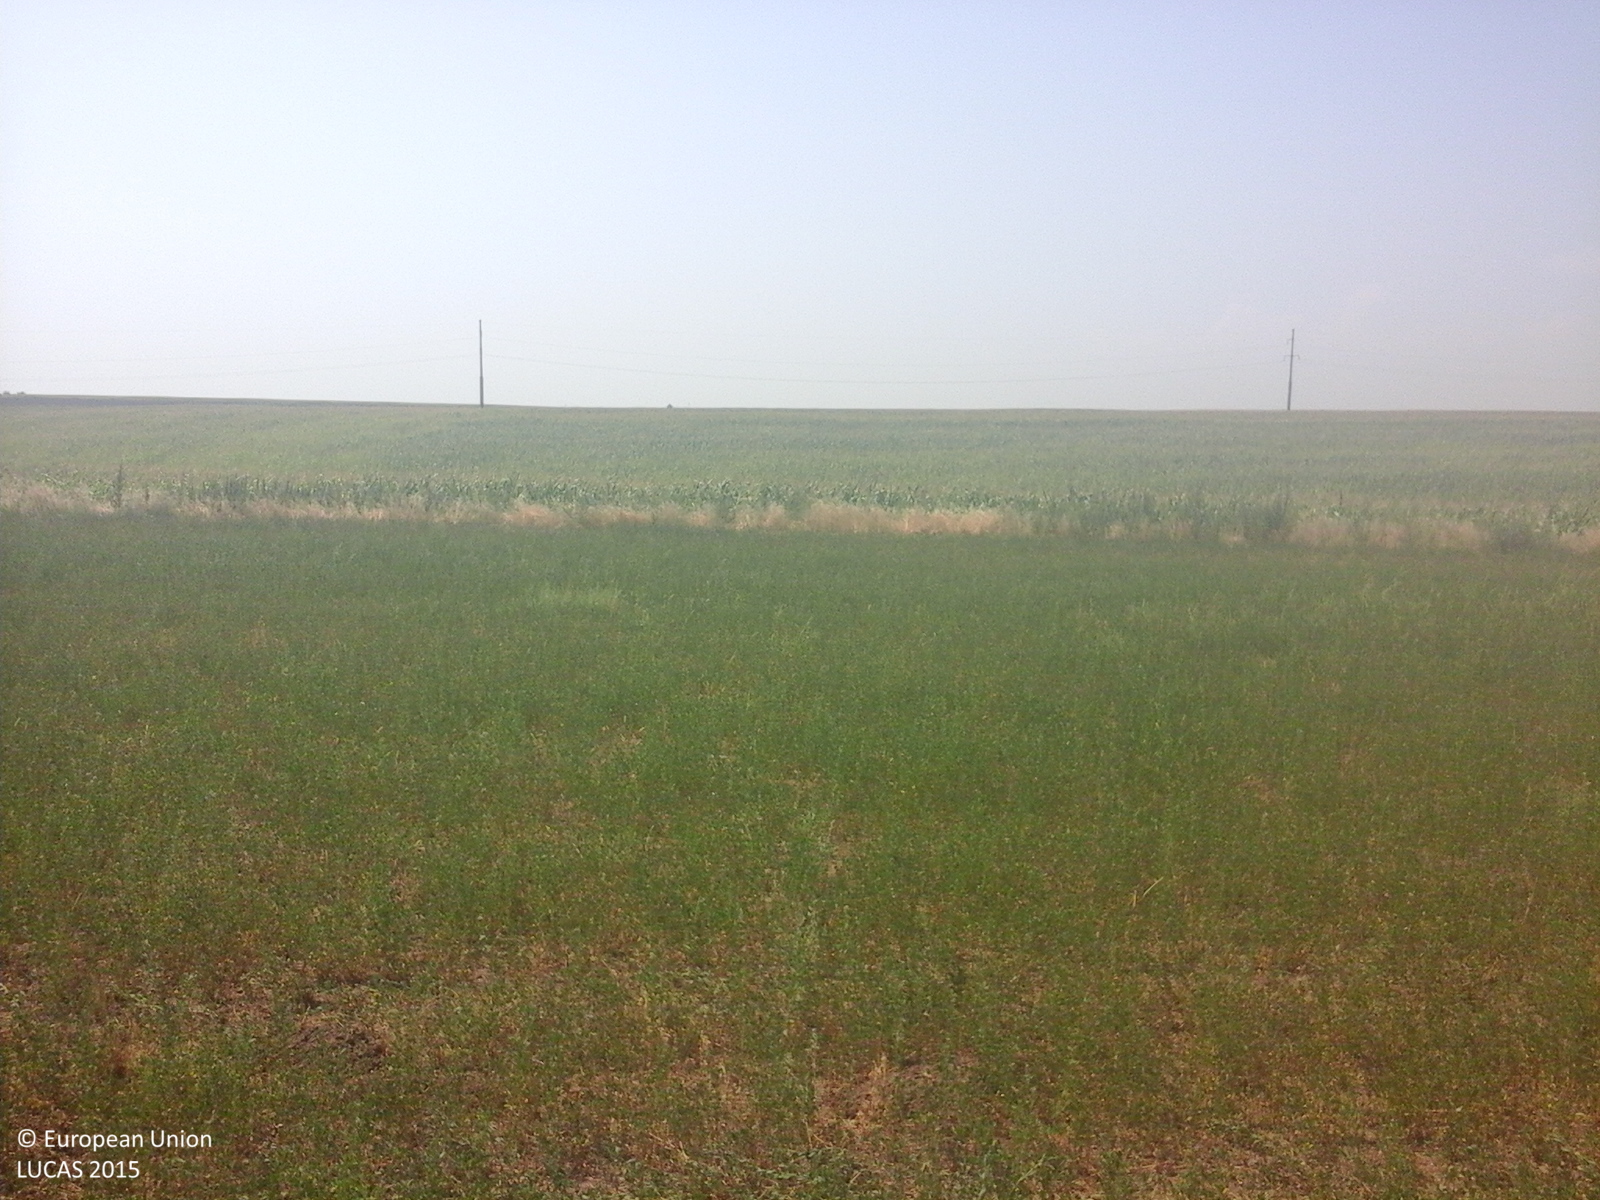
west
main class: Cropland
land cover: Lucerne
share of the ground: > 75 %
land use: Agriculture (excluding fallow land and kitchen gardens)
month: July
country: RO
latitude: 45.4953
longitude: 27.8622
